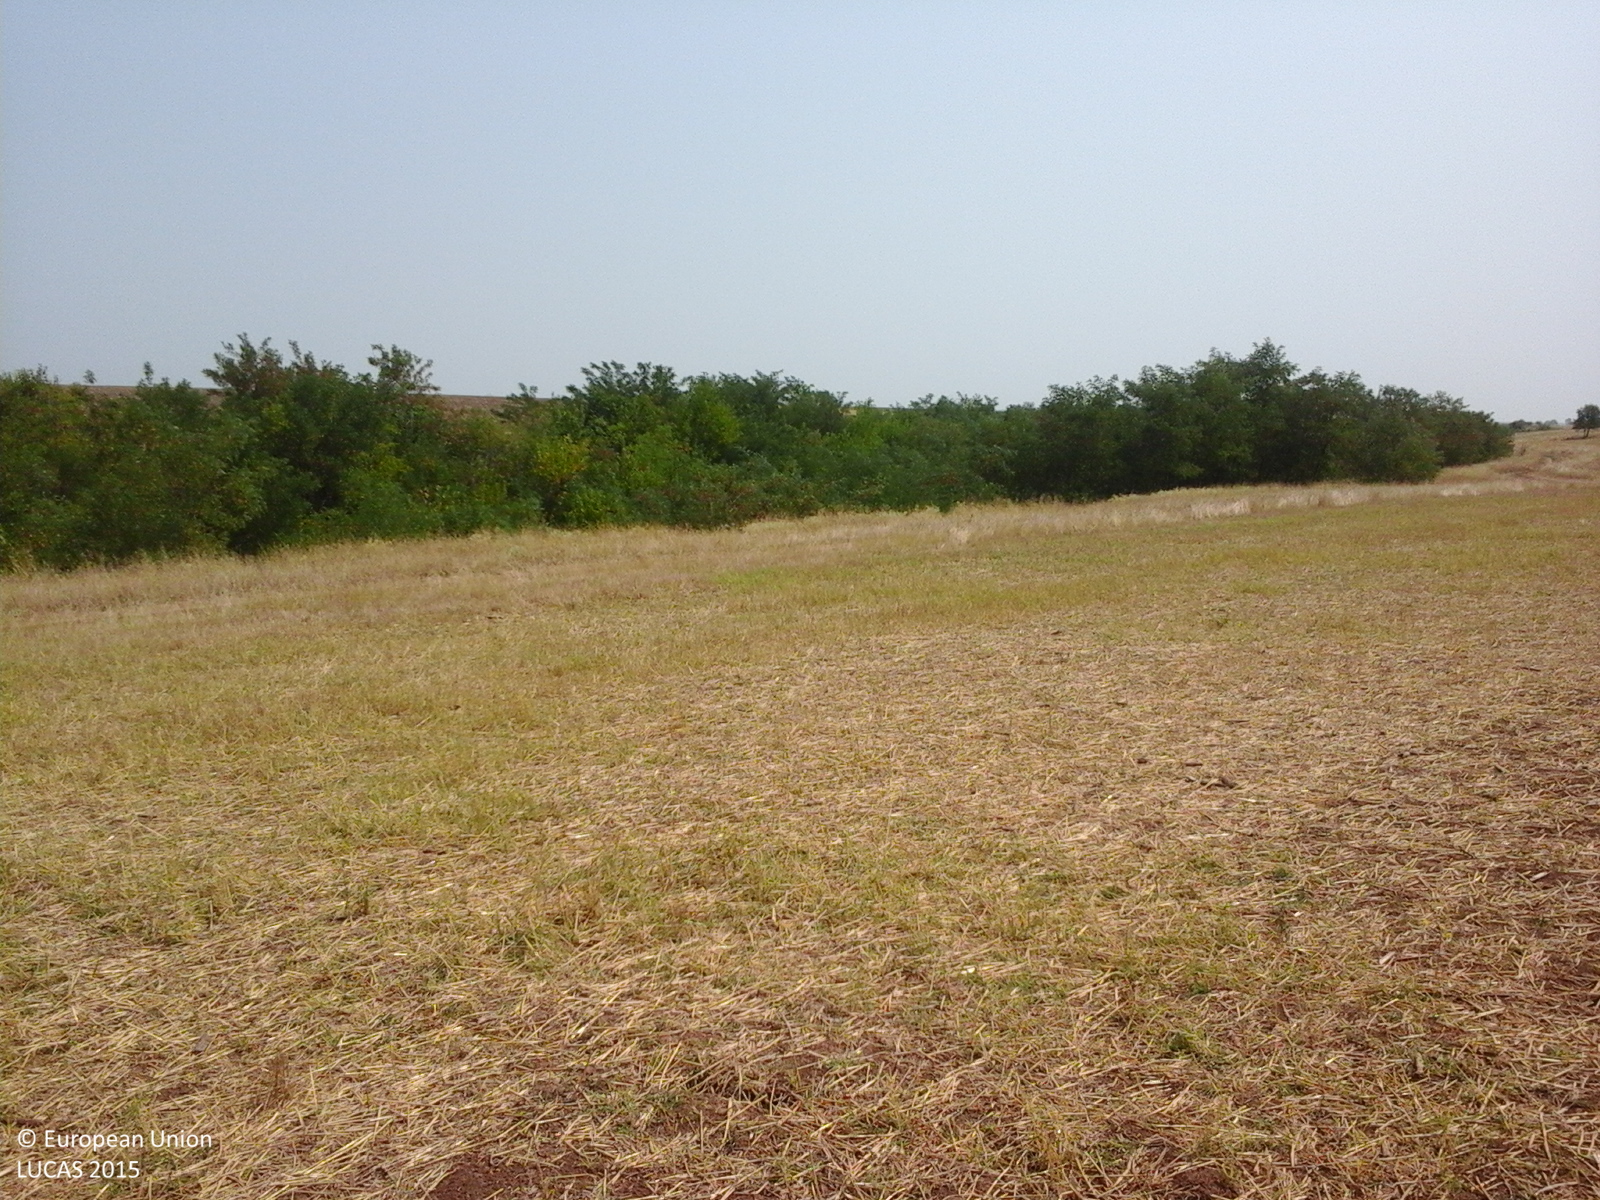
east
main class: Cropland
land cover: Common wheat
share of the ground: 50 - 75 %
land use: Agriculture (excluding fallow land and kitchen gardens)
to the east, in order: Common wheat; Tracks; Grassland without tree/shrub cover; Broadleaved woodland; Grass margins; Rape and turnip rape
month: August
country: RO
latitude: 44.3037
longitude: 23.5018
